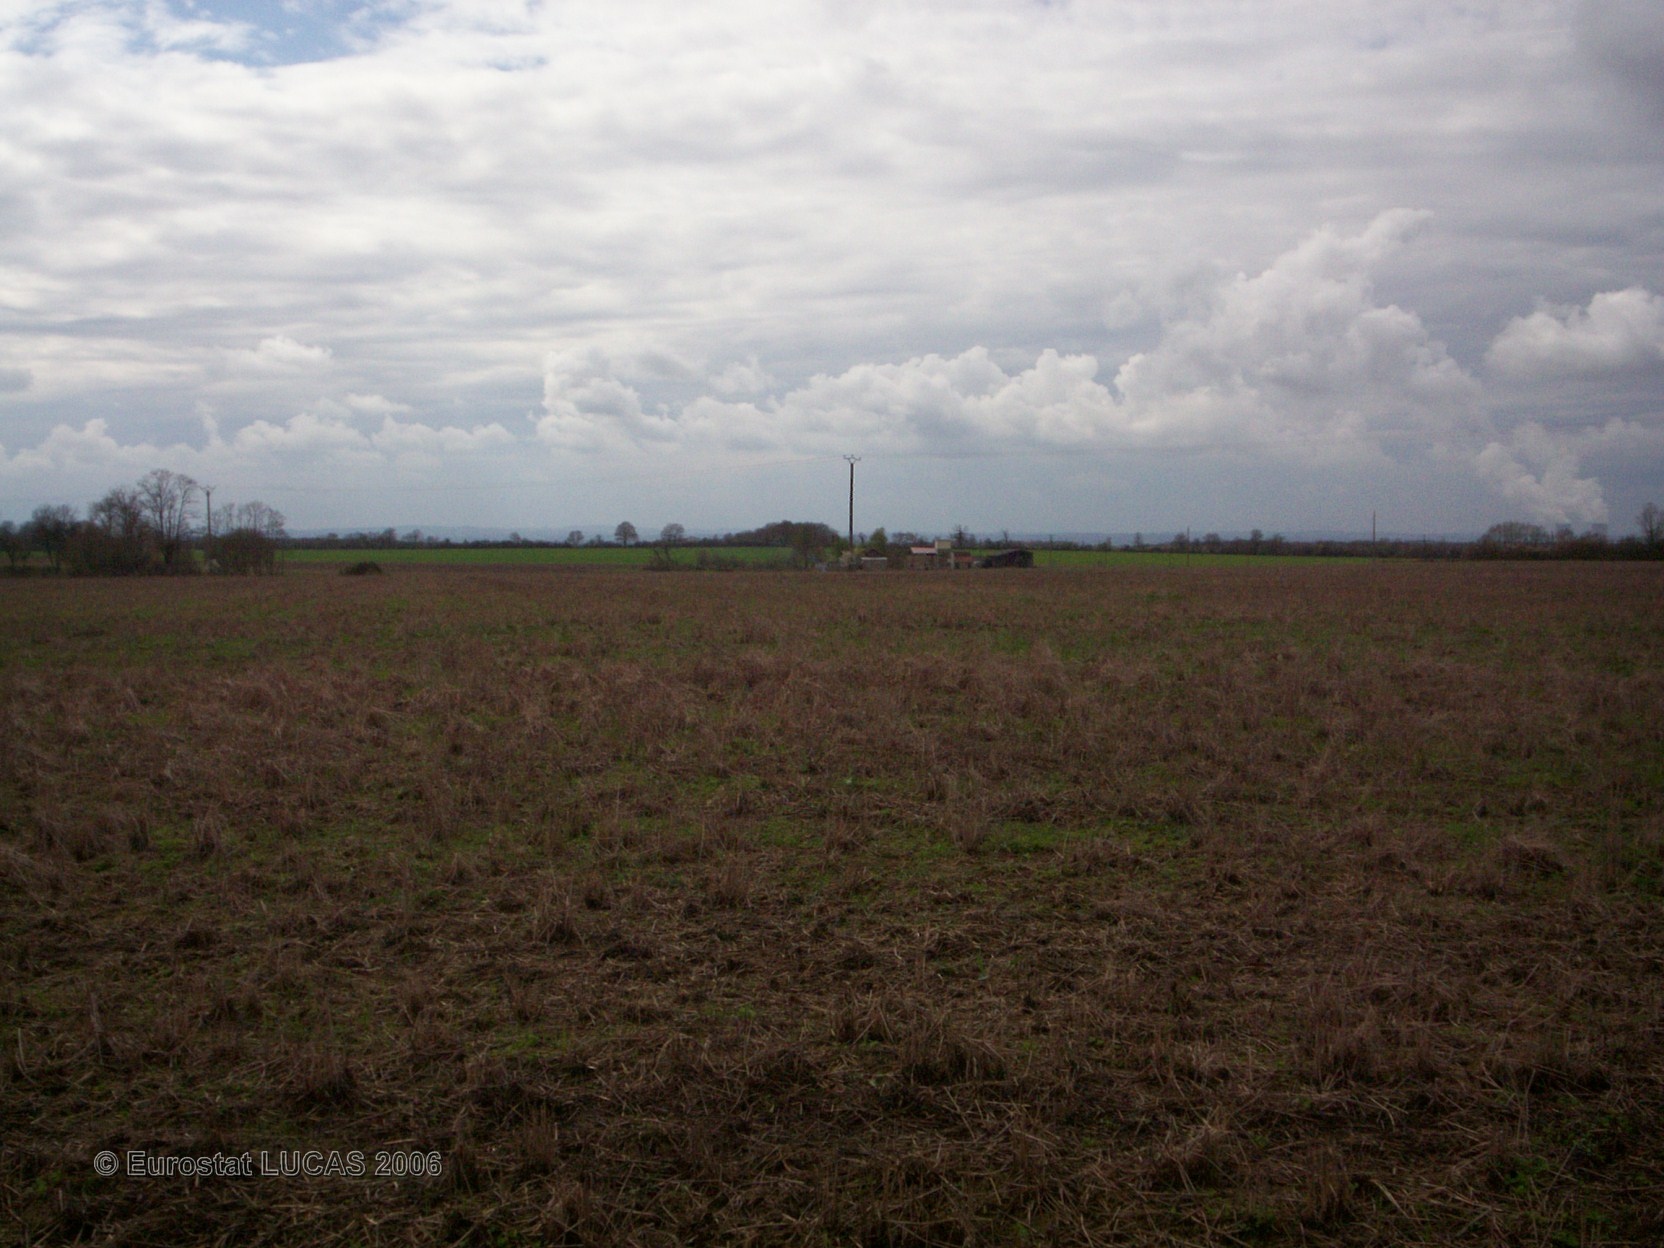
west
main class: Cropland
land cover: Other leguminous and mixtures for fodder
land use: Agriculture (excluding fallow land and kitchen gardens)
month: May
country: FR
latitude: 47.4772
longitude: 3.0013
